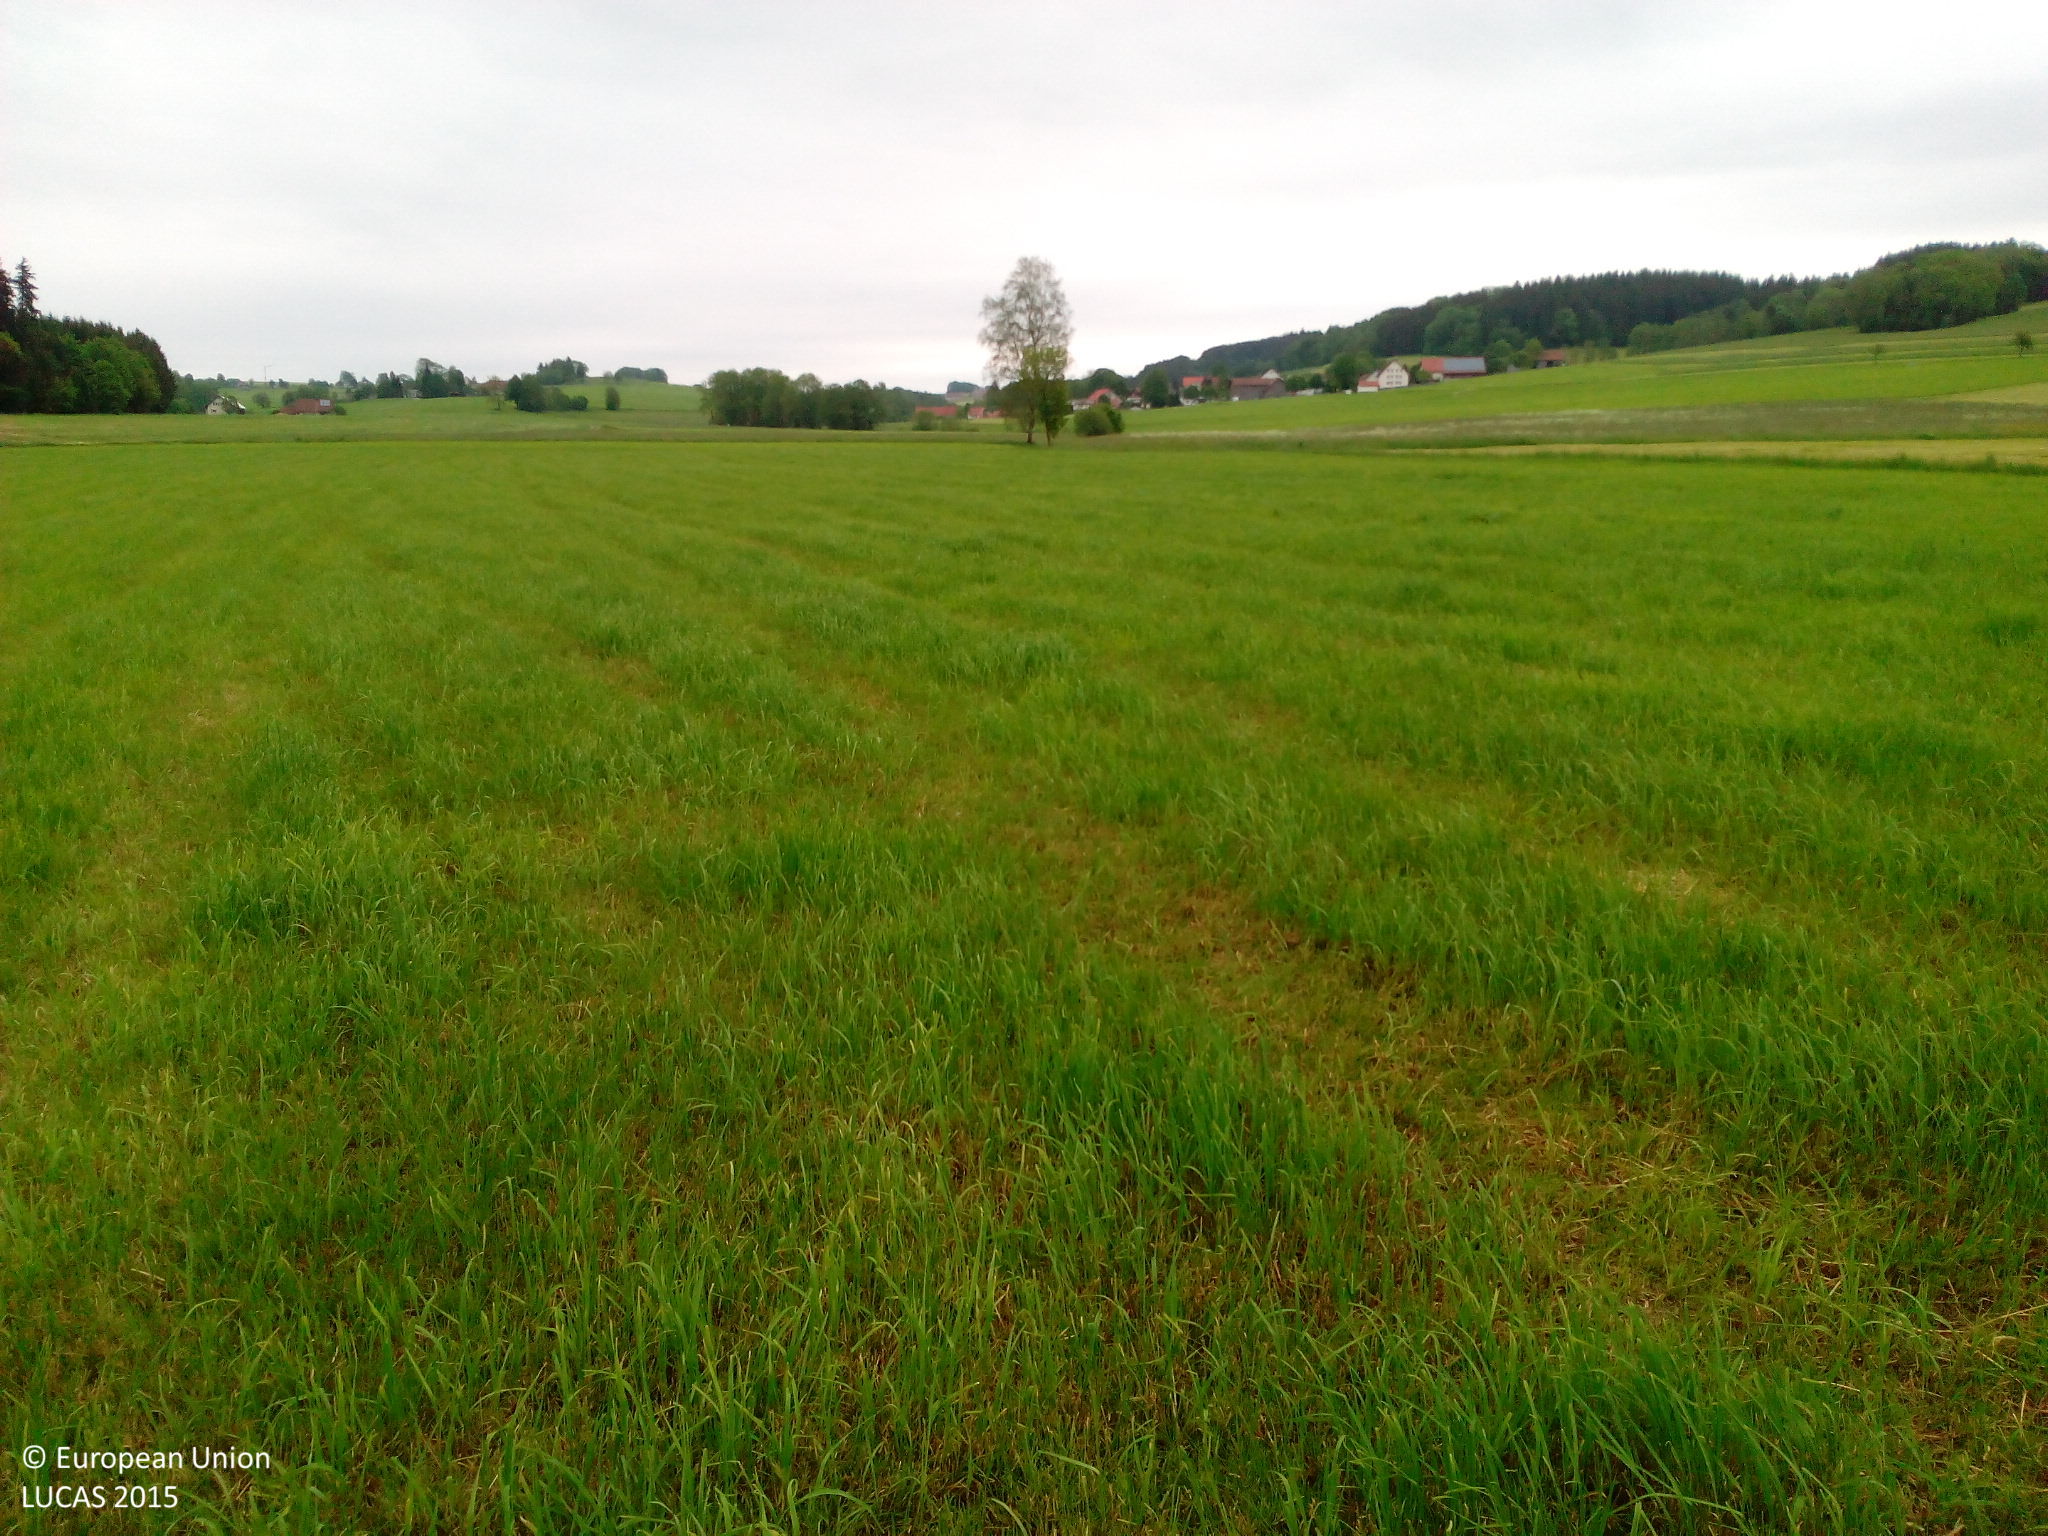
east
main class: Grassland
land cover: Grassland without tree/shrub cover
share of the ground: > 75 %
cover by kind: herbaceous plants 100 %
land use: Agriculture (excluding fallow land and kitchen gardens)
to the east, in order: Grassland without tree/shrub cover; Shrubland with sparse tree cover; Rivers and streams; Shruby margins; Grassland without tree/shrub cover; Ditches and canals; Grassland without tree/shrub cover
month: May
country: DE
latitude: 47.8816
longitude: 9.9332
